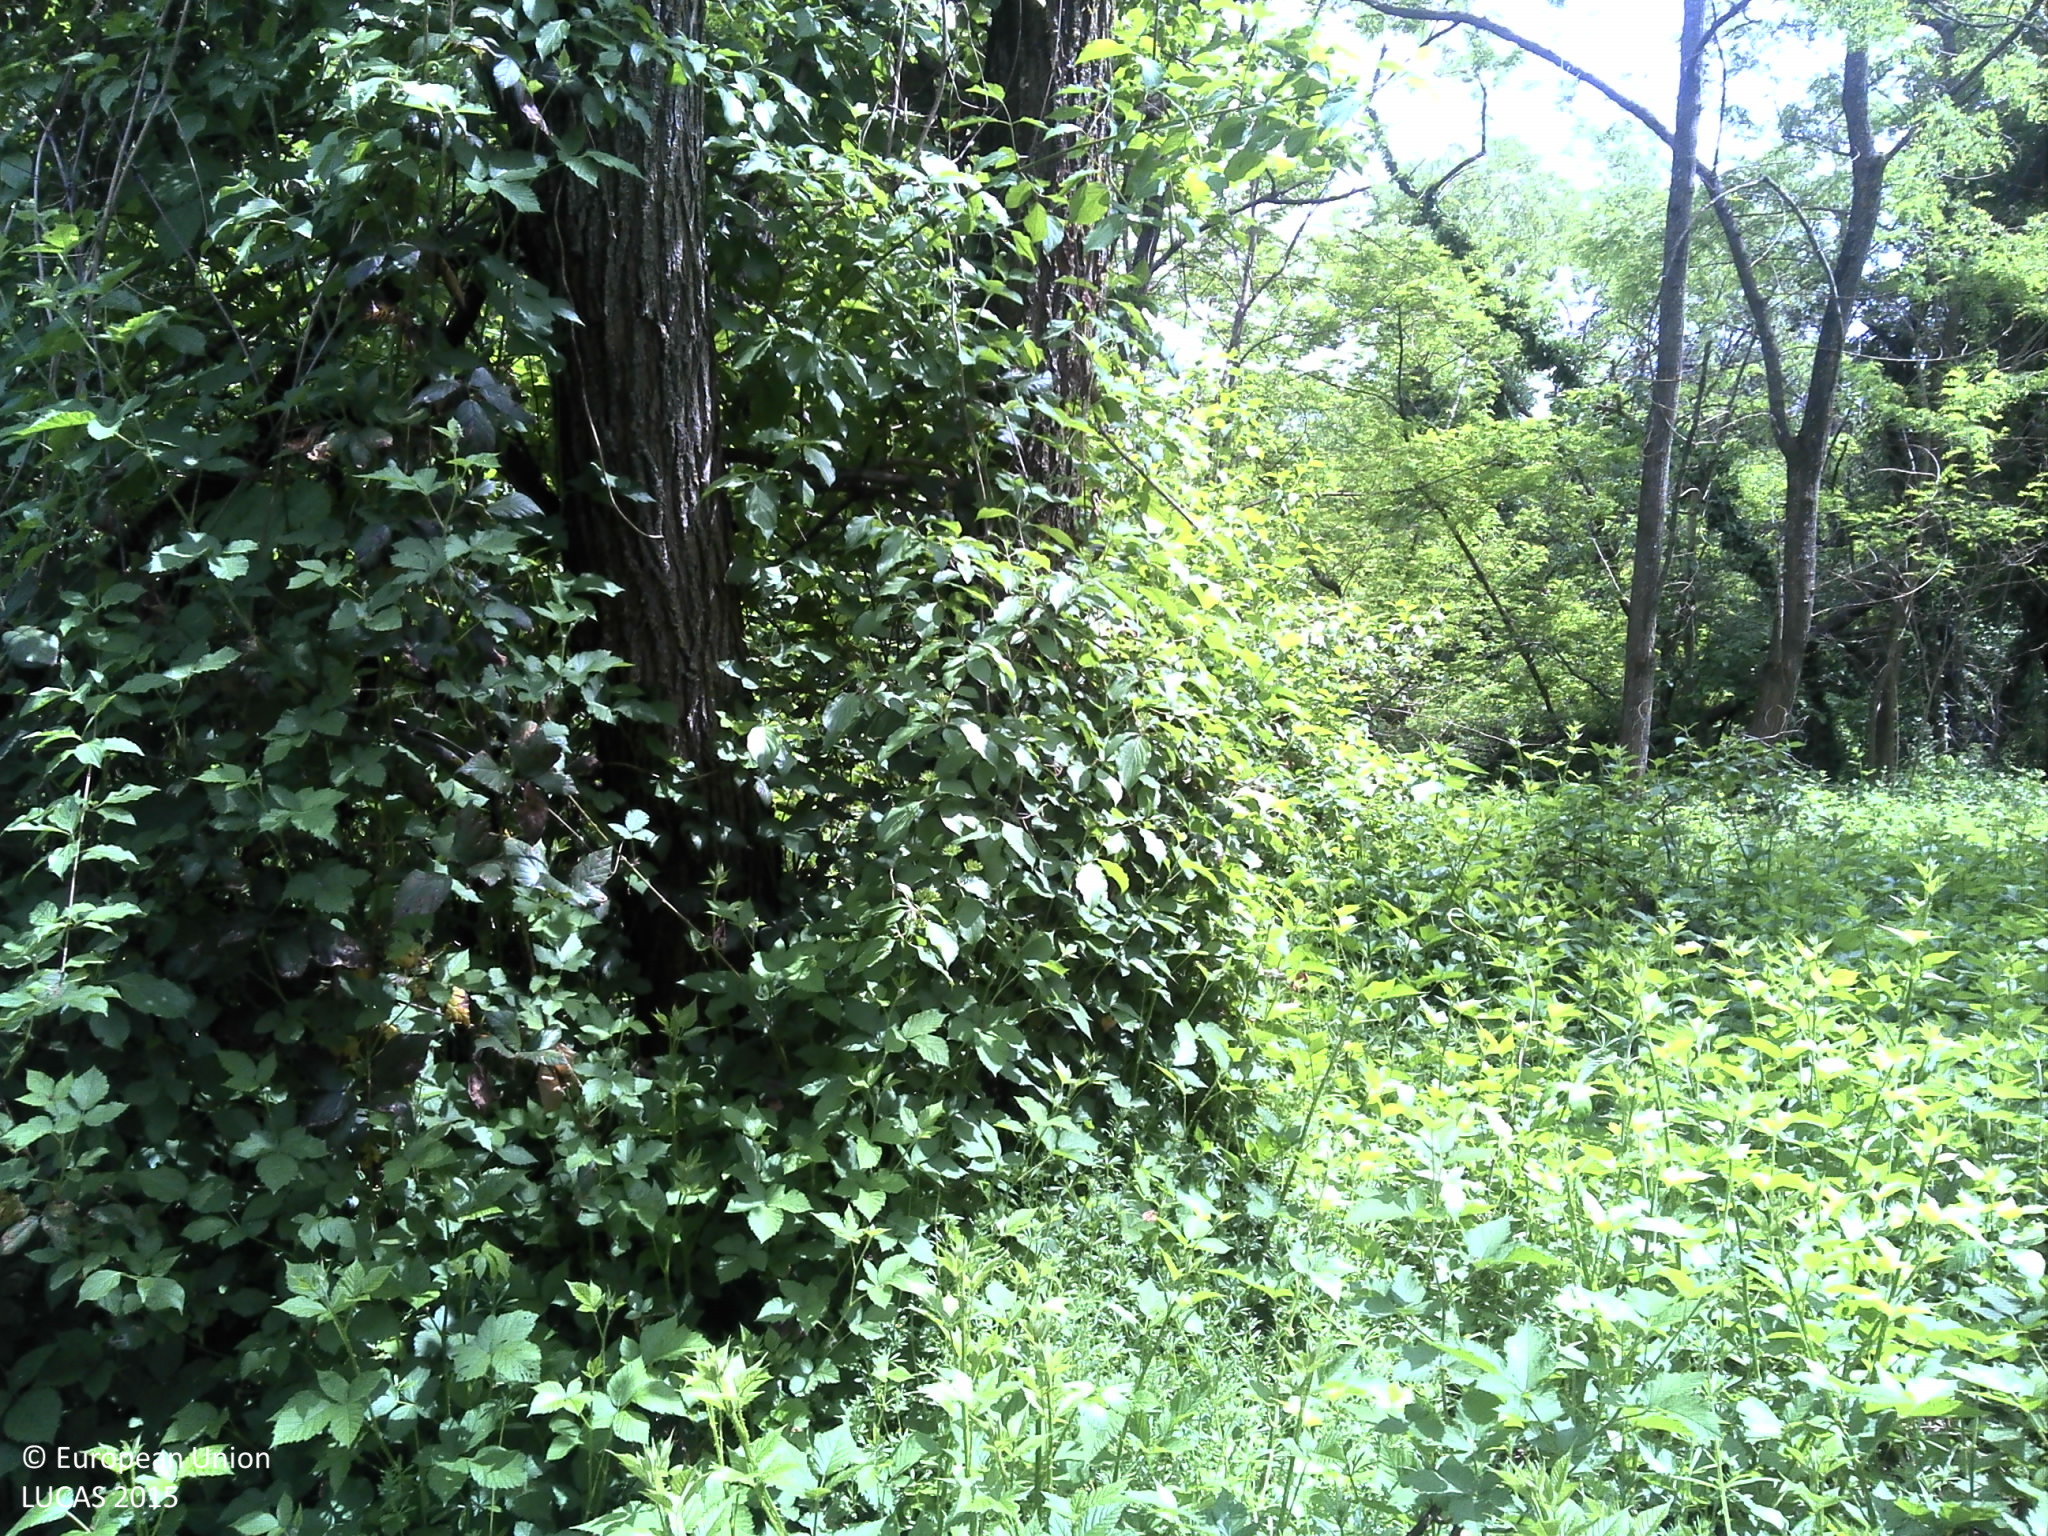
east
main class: Woodland
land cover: Broadleaved woodland
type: acidophilous oak and oak-birch forest
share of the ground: > 75 %
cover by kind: broadleaved forest trees 80 %, lichens and mosses 20 %
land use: Forestry
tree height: > 5 m
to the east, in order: Broadleaved woodland
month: May
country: HR
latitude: 45.3372
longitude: 18.1068
